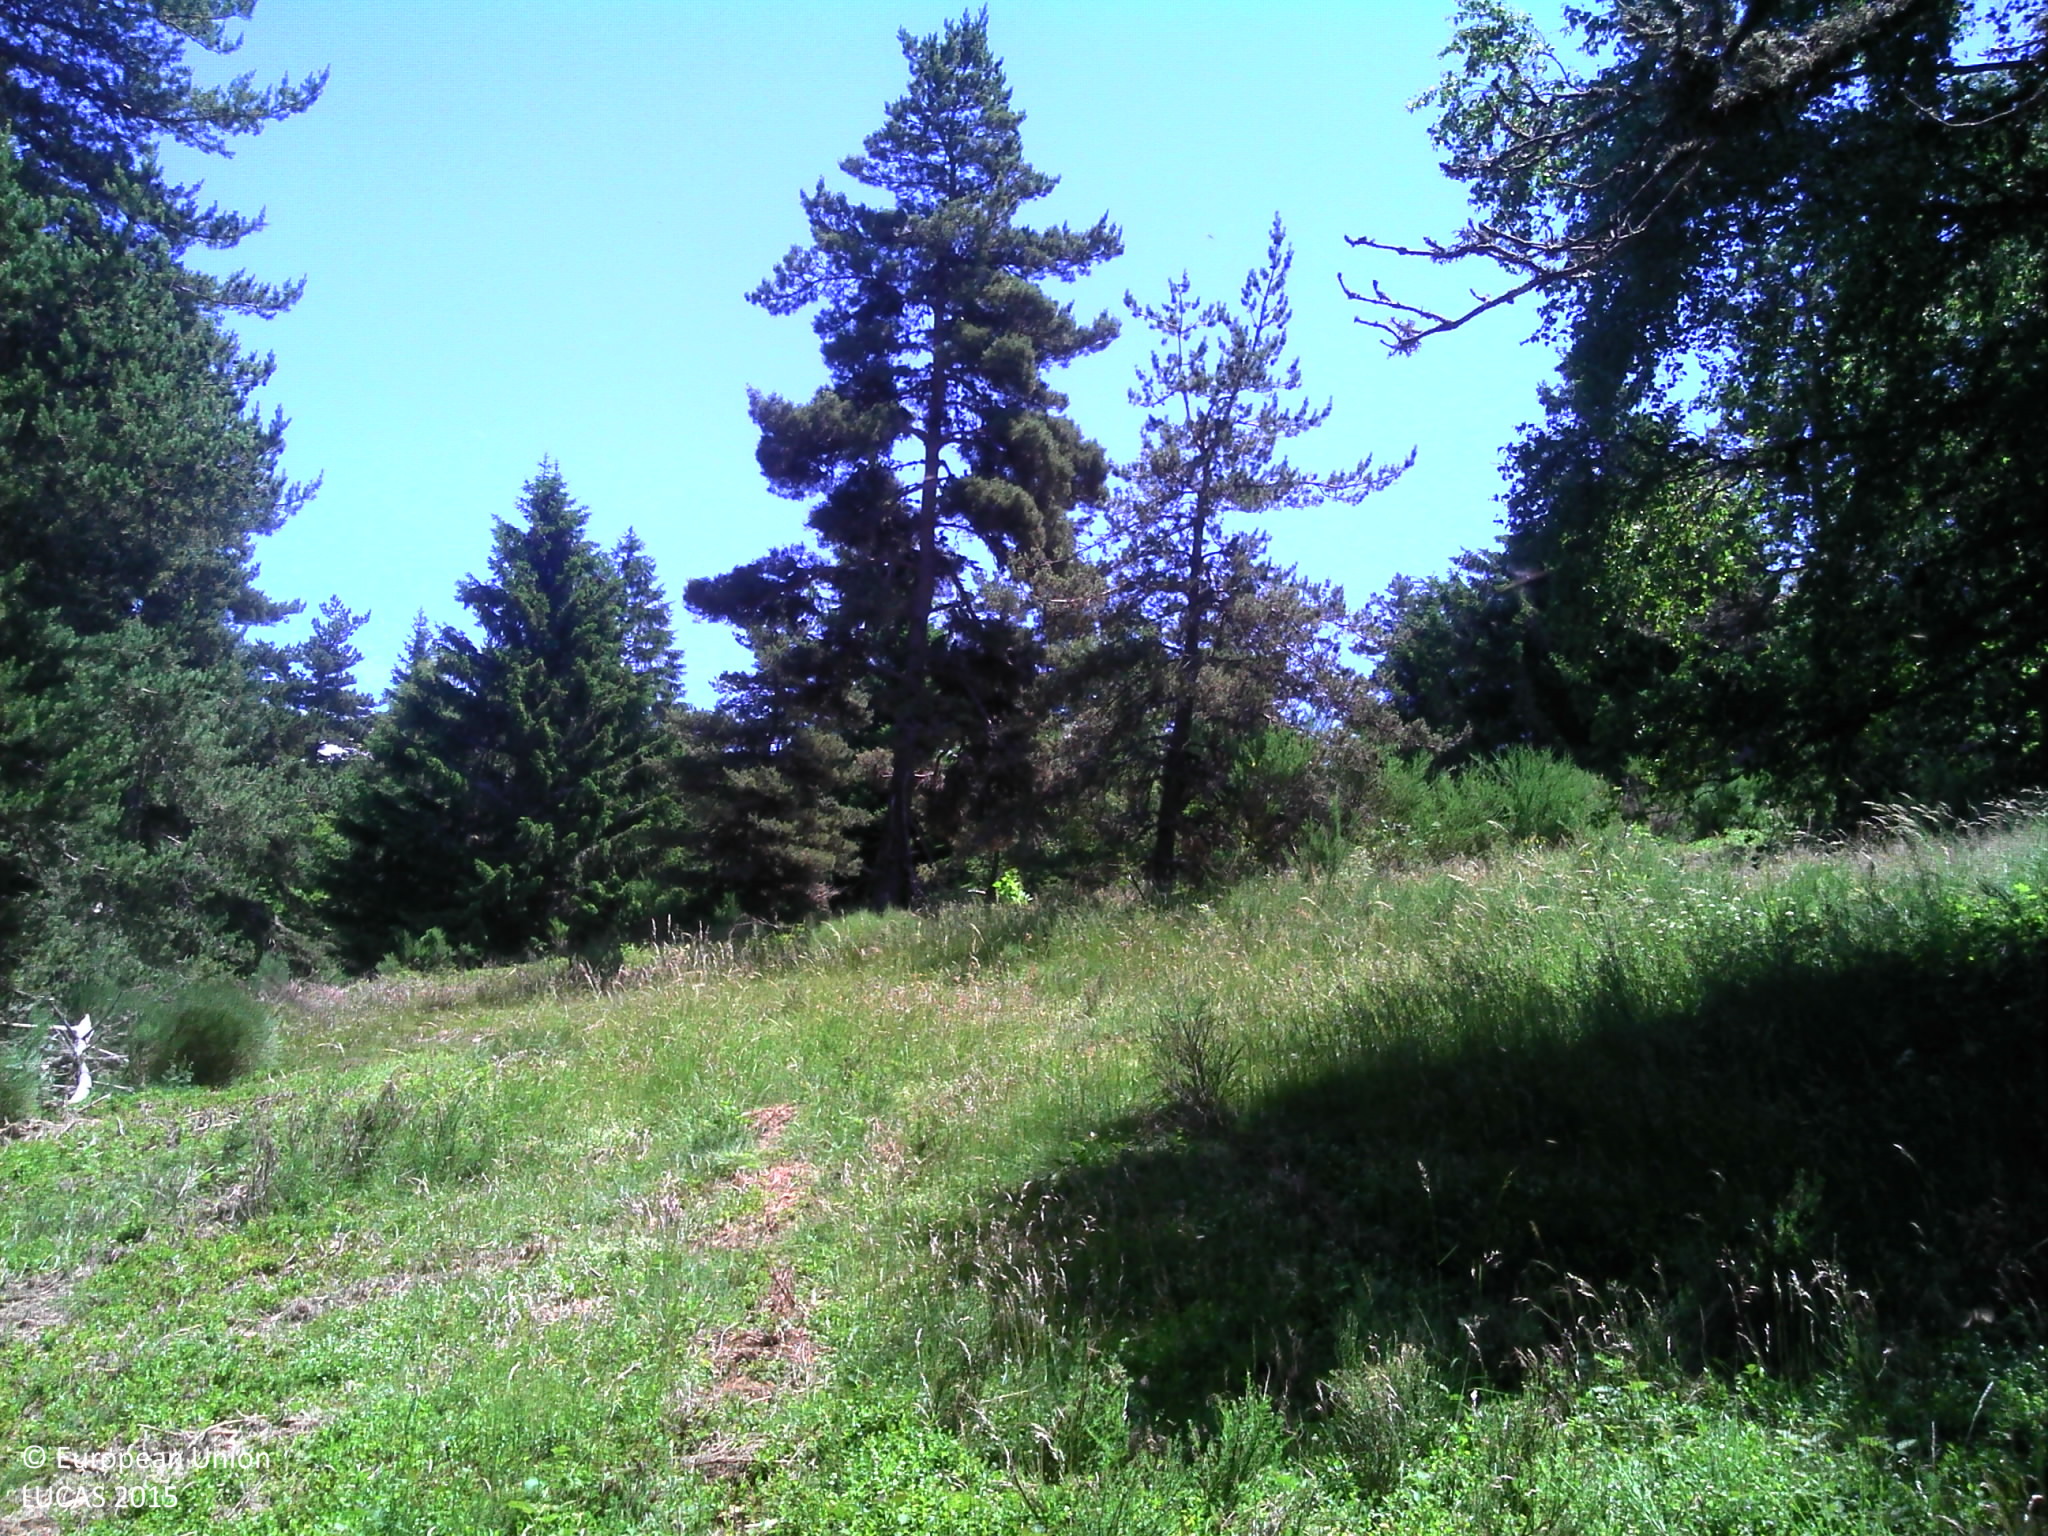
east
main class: Woodland
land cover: Pine dominated mixed woodland
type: mountainous beech forest
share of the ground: 50 - 75 %
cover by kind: herbaceous plants 40 %, broadleaved forest trees 35 %, coniferous forest trees 25 %
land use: Forestry
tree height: > 5 m
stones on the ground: 10 - 25 %
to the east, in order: Pine dominated mixed woodland; Spruce dominated coniferous woodland; Rivers and streams; Spruce dominated coniferous woodland; Rivers and streams; Spruce dominated mixed woodland; Grassland with sparse tree/shrub cover
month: June
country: FR
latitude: 44.5788
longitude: 3.4686
